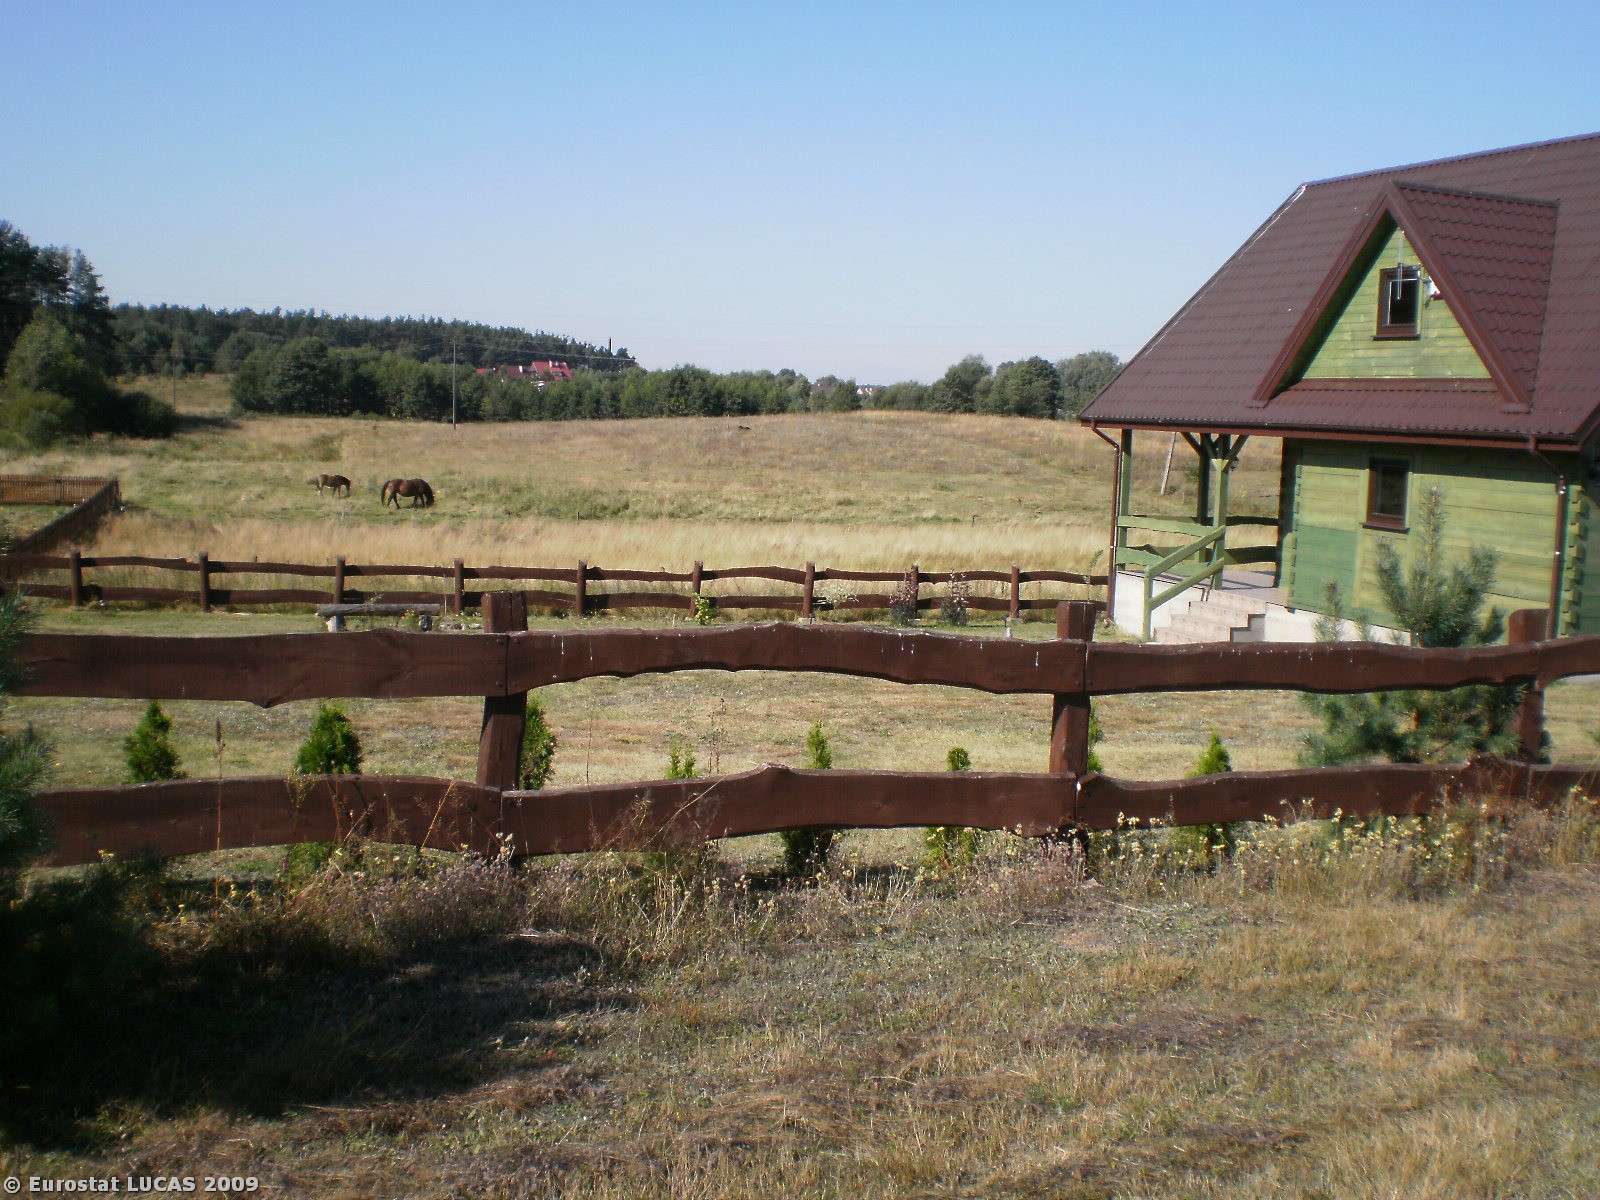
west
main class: Grassland
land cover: Grassland with sparse tree/shrub cover
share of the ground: > 75 %
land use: Agriculture (excluding fallow land and kitchen gardens)
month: September
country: PL
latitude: 53.6093
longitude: 21.3688
